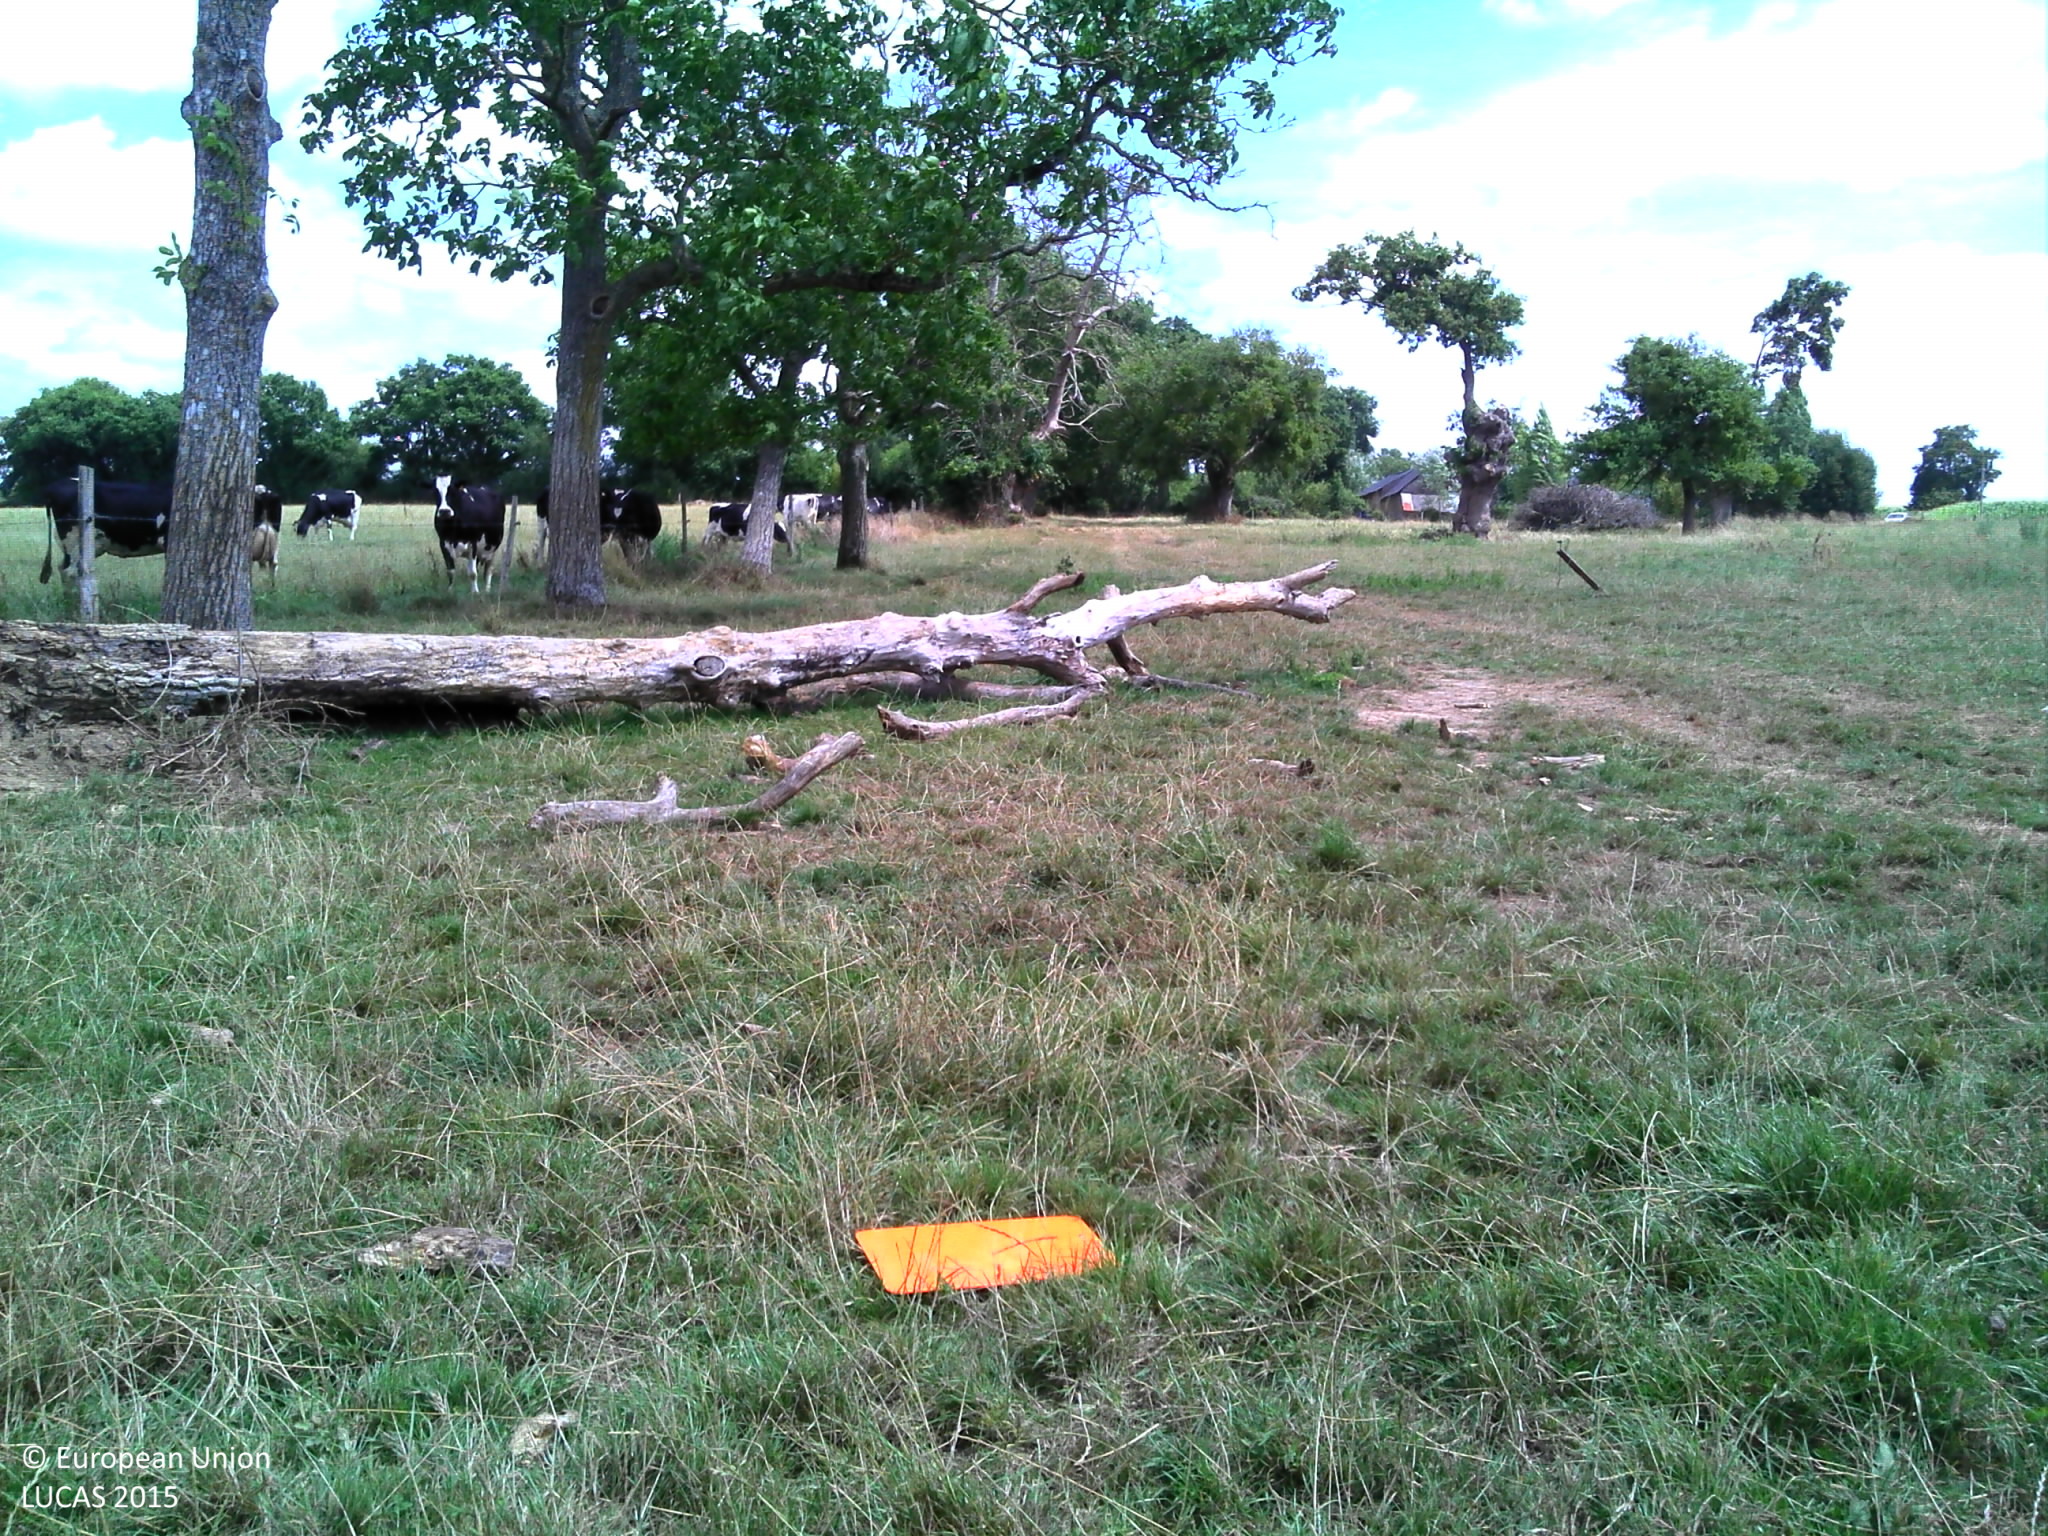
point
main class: Grassland
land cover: Grassland without tree/shrub cover
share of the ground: > 75 %
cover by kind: herbaceous plants 100 %
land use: Agriculture (excluding fallow land and kitchen gardens)
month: August
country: FR
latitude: 47.7427
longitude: -1.3650
